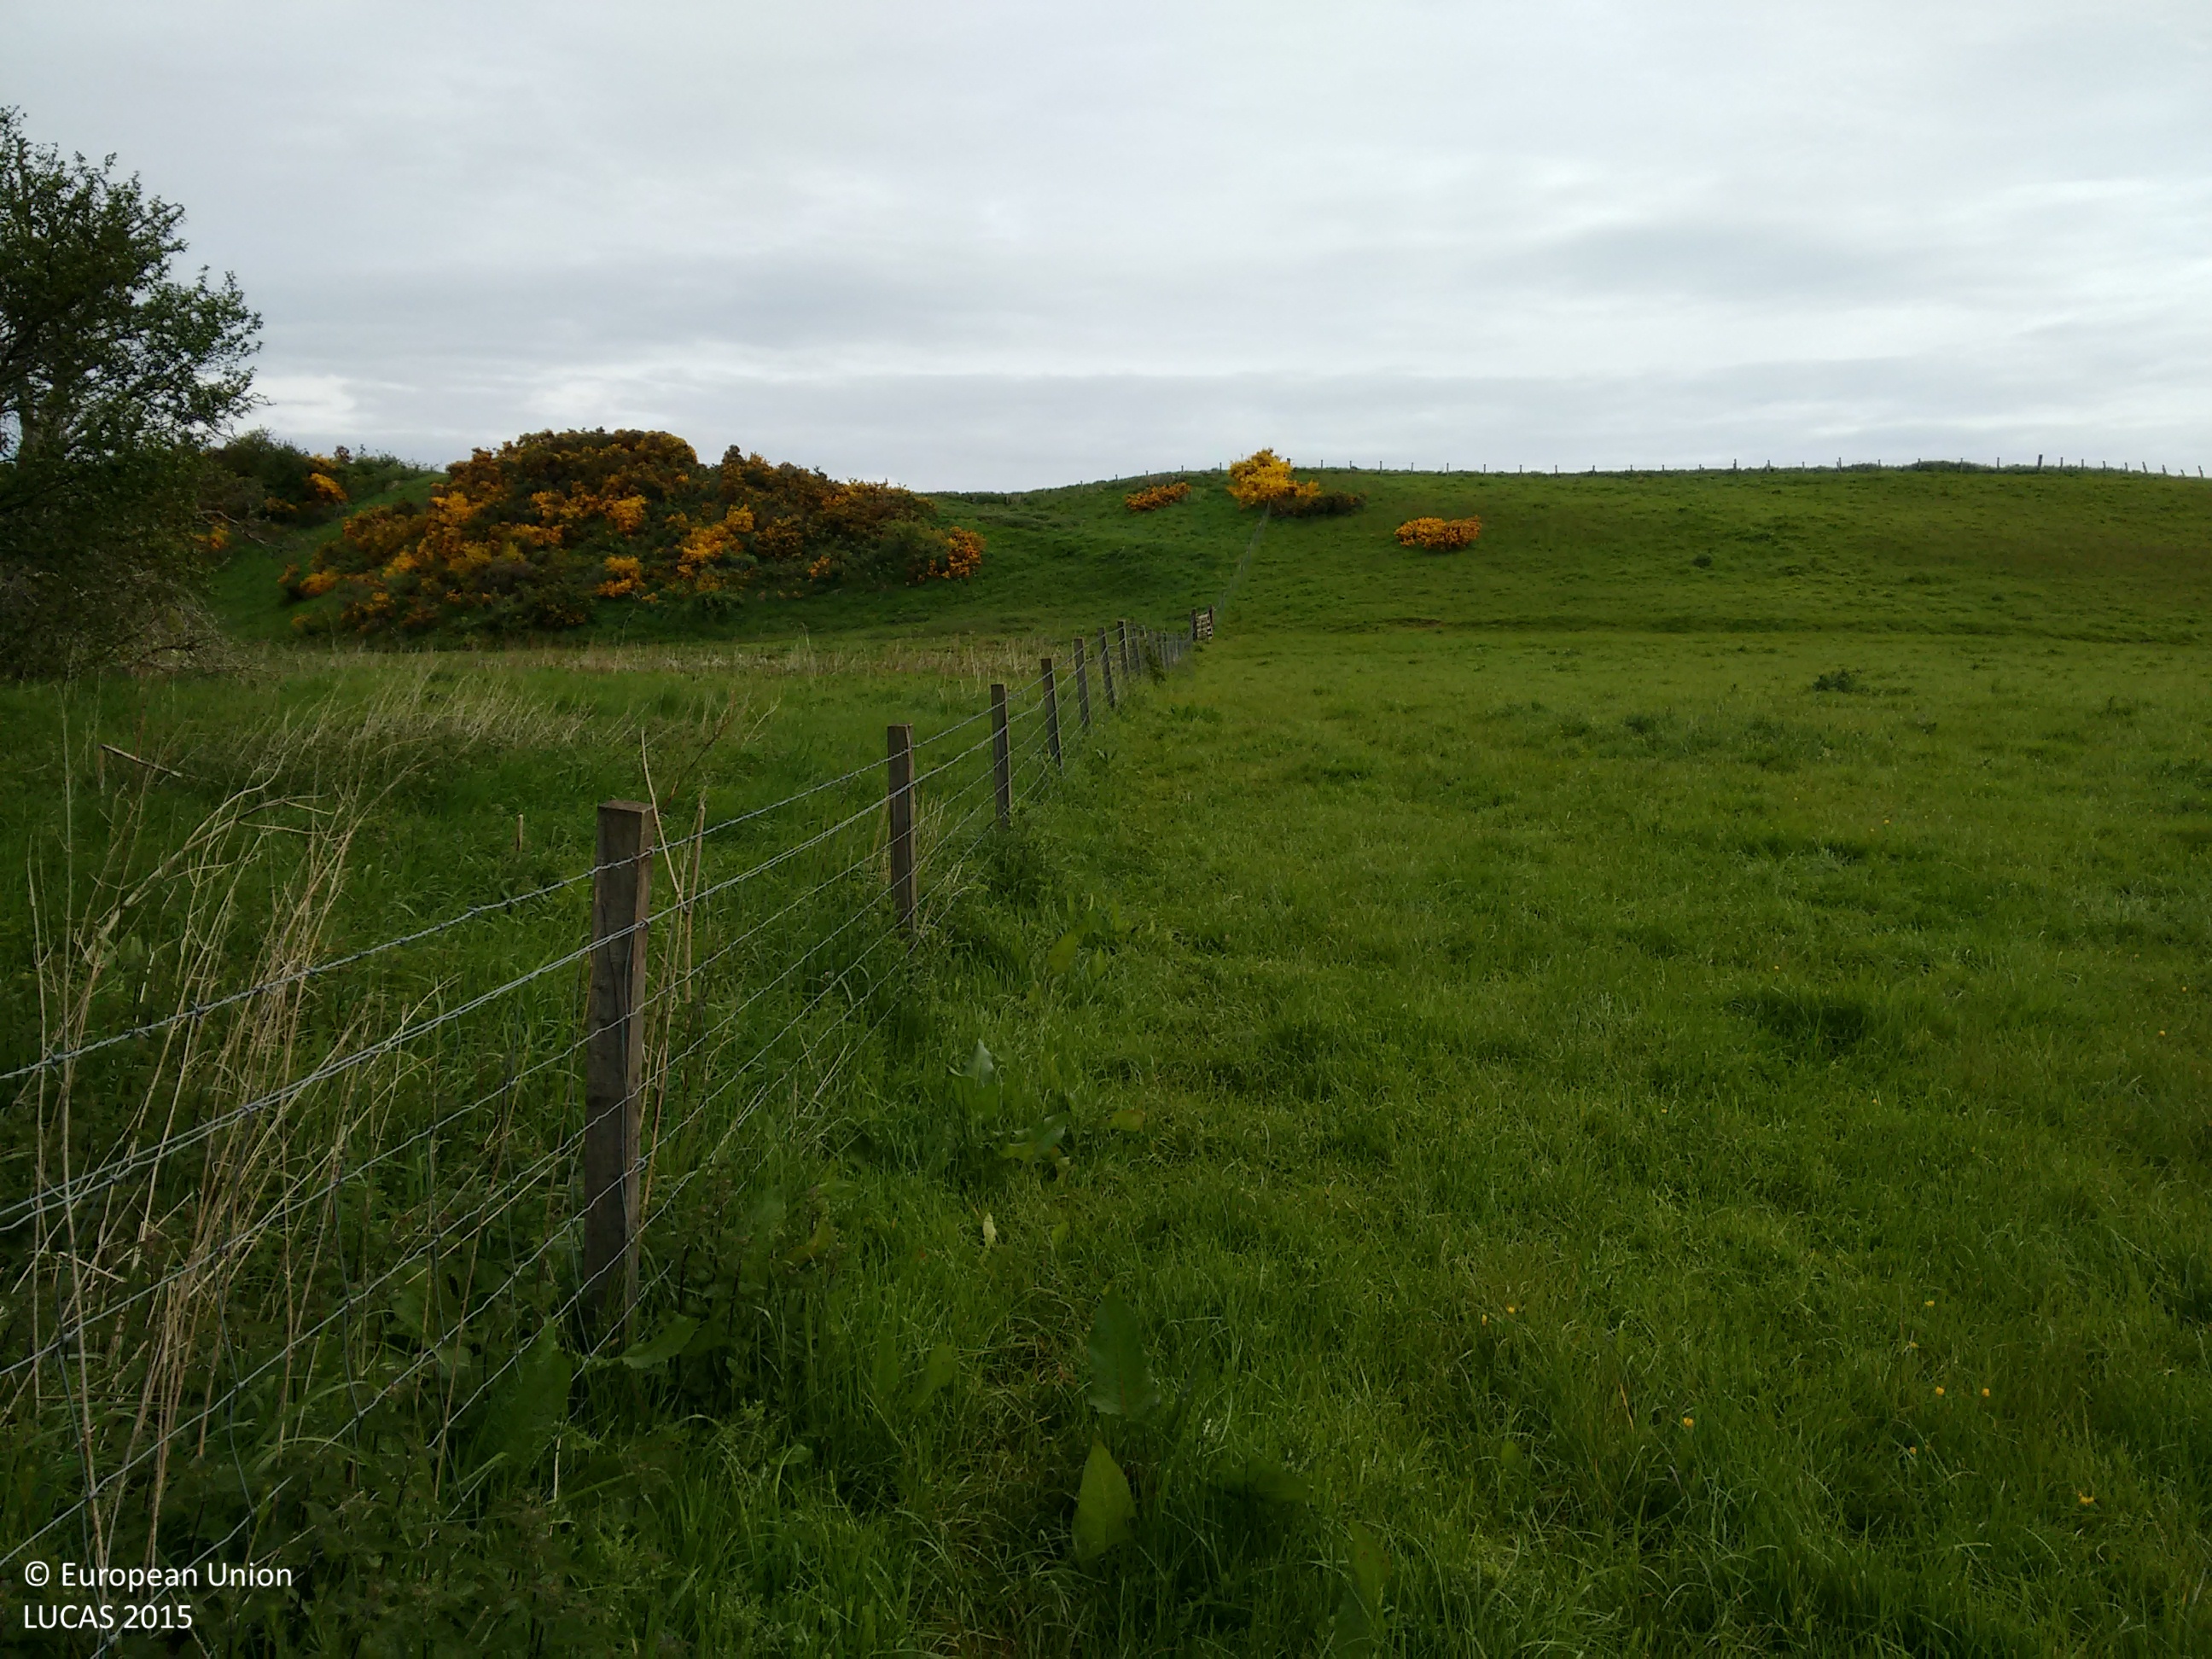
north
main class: Grassland
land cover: Grassland without tree/shrub cover
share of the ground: > 75 %
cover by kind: herbaceous plants 100 %
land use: Agriculture (excluding fallow land and kitchen gardens)
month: June
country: GB
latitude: 56.4533
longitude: -3.5266
